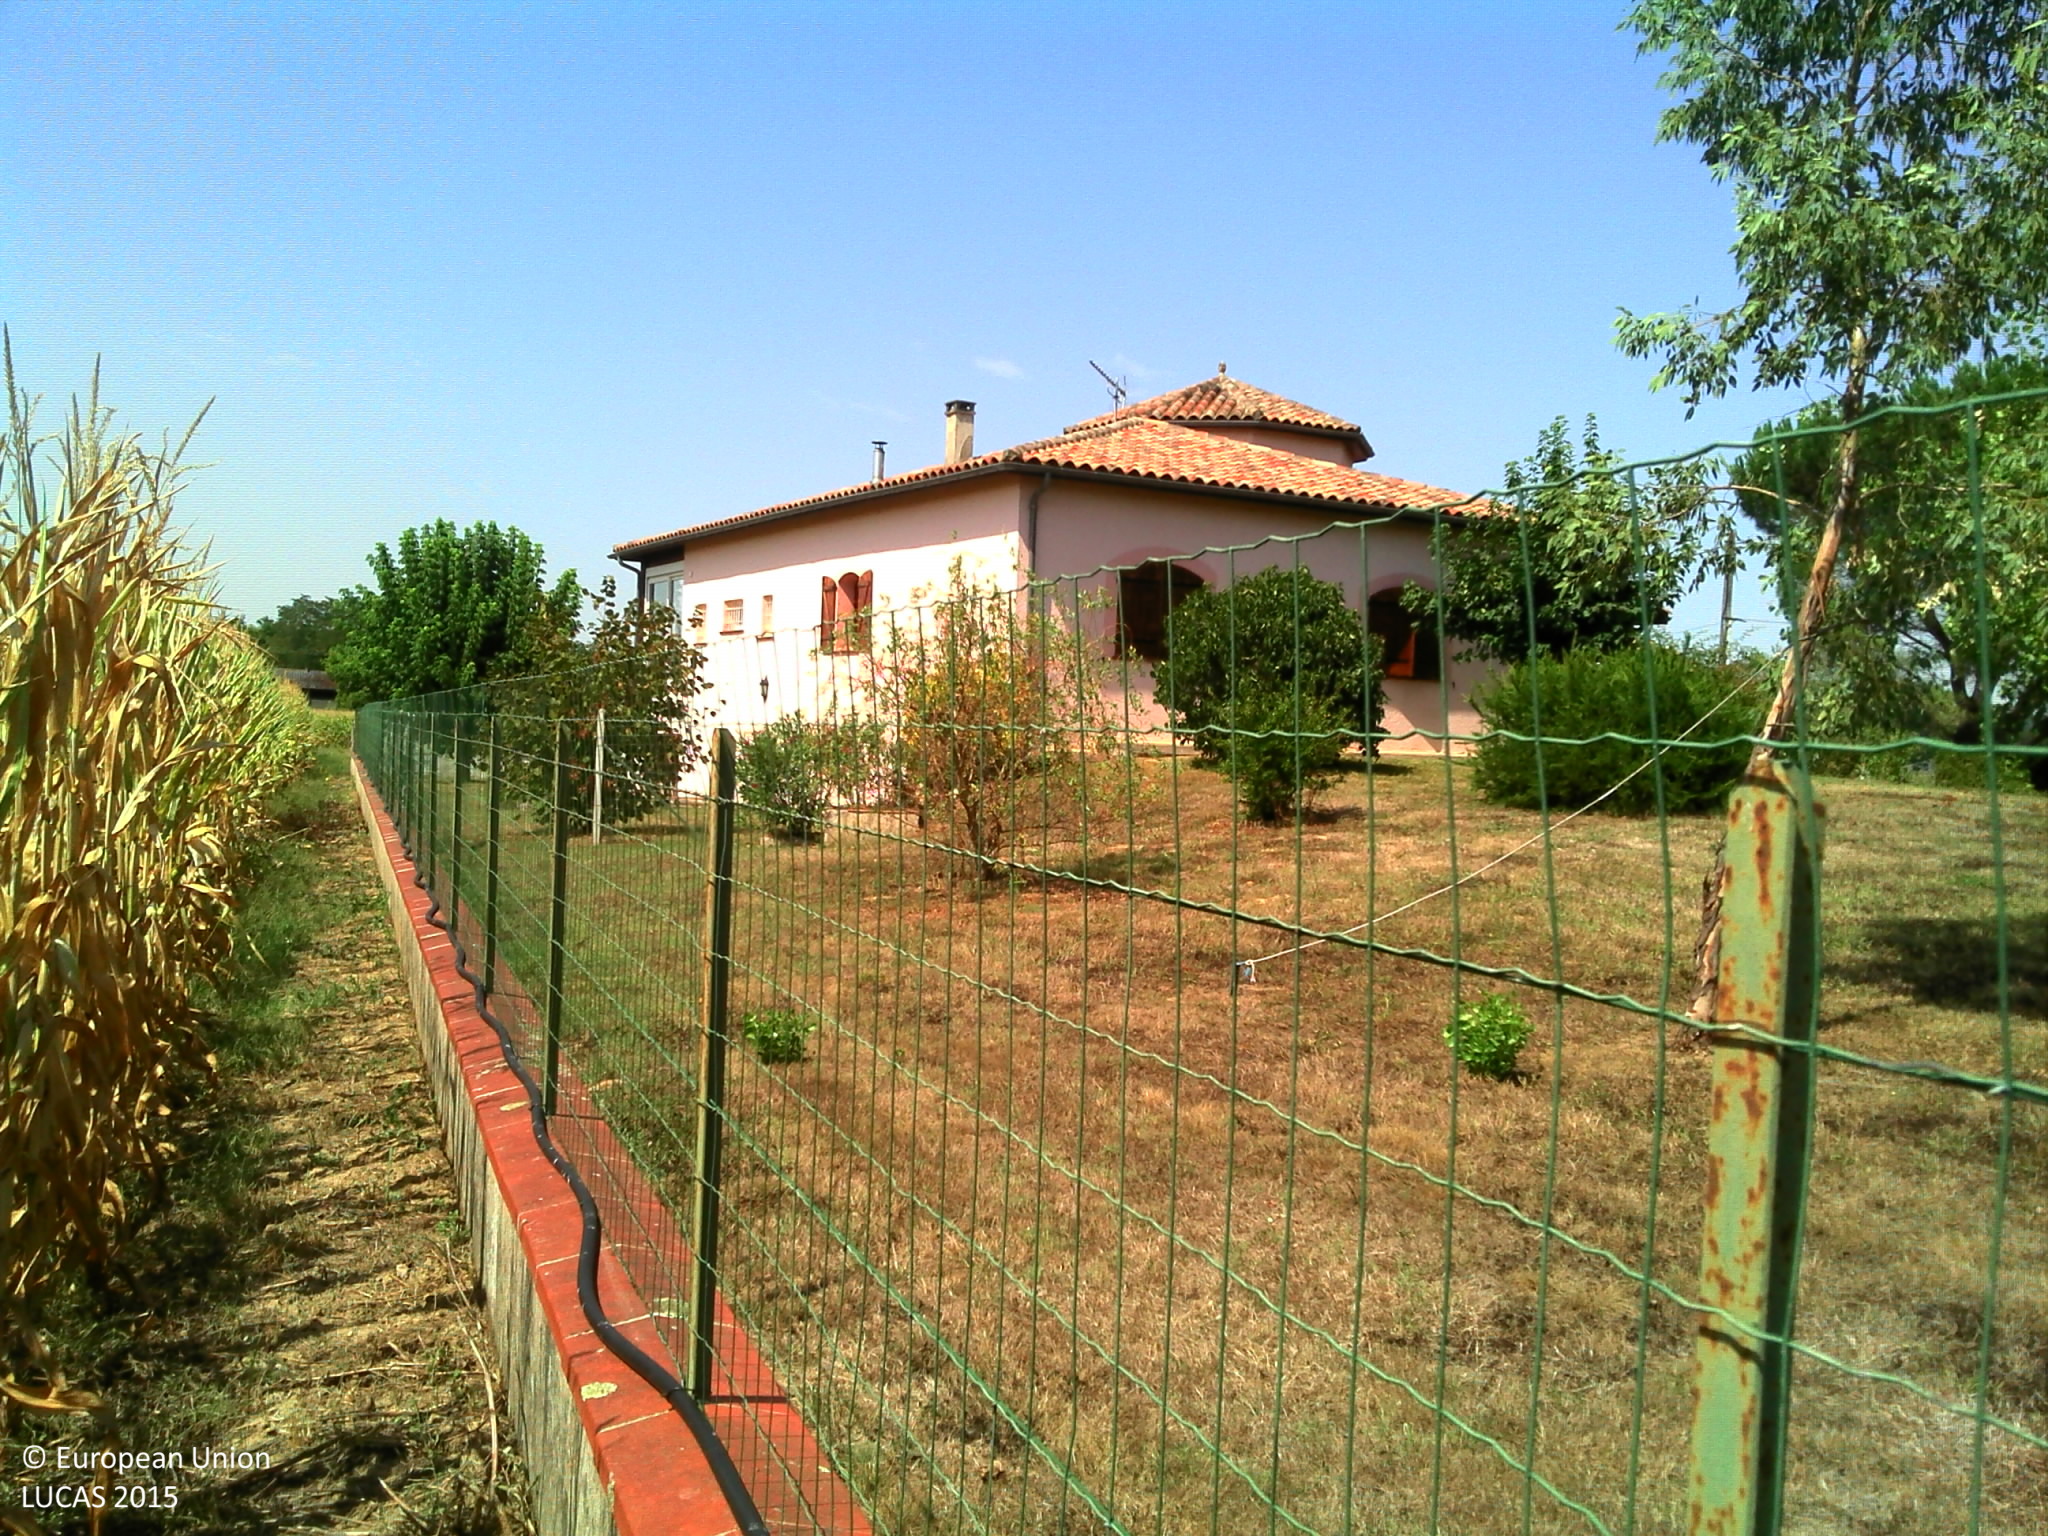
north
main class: Grassland
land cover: Grassland with sparse tree/shrub cover
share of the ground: > 75 %
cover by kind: herbaceous plants 90 %, broadleaved forest trees 5 %, shrubs 5 %
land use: Residential
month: August
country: FR
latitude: 44.1661
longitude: 0.6784
